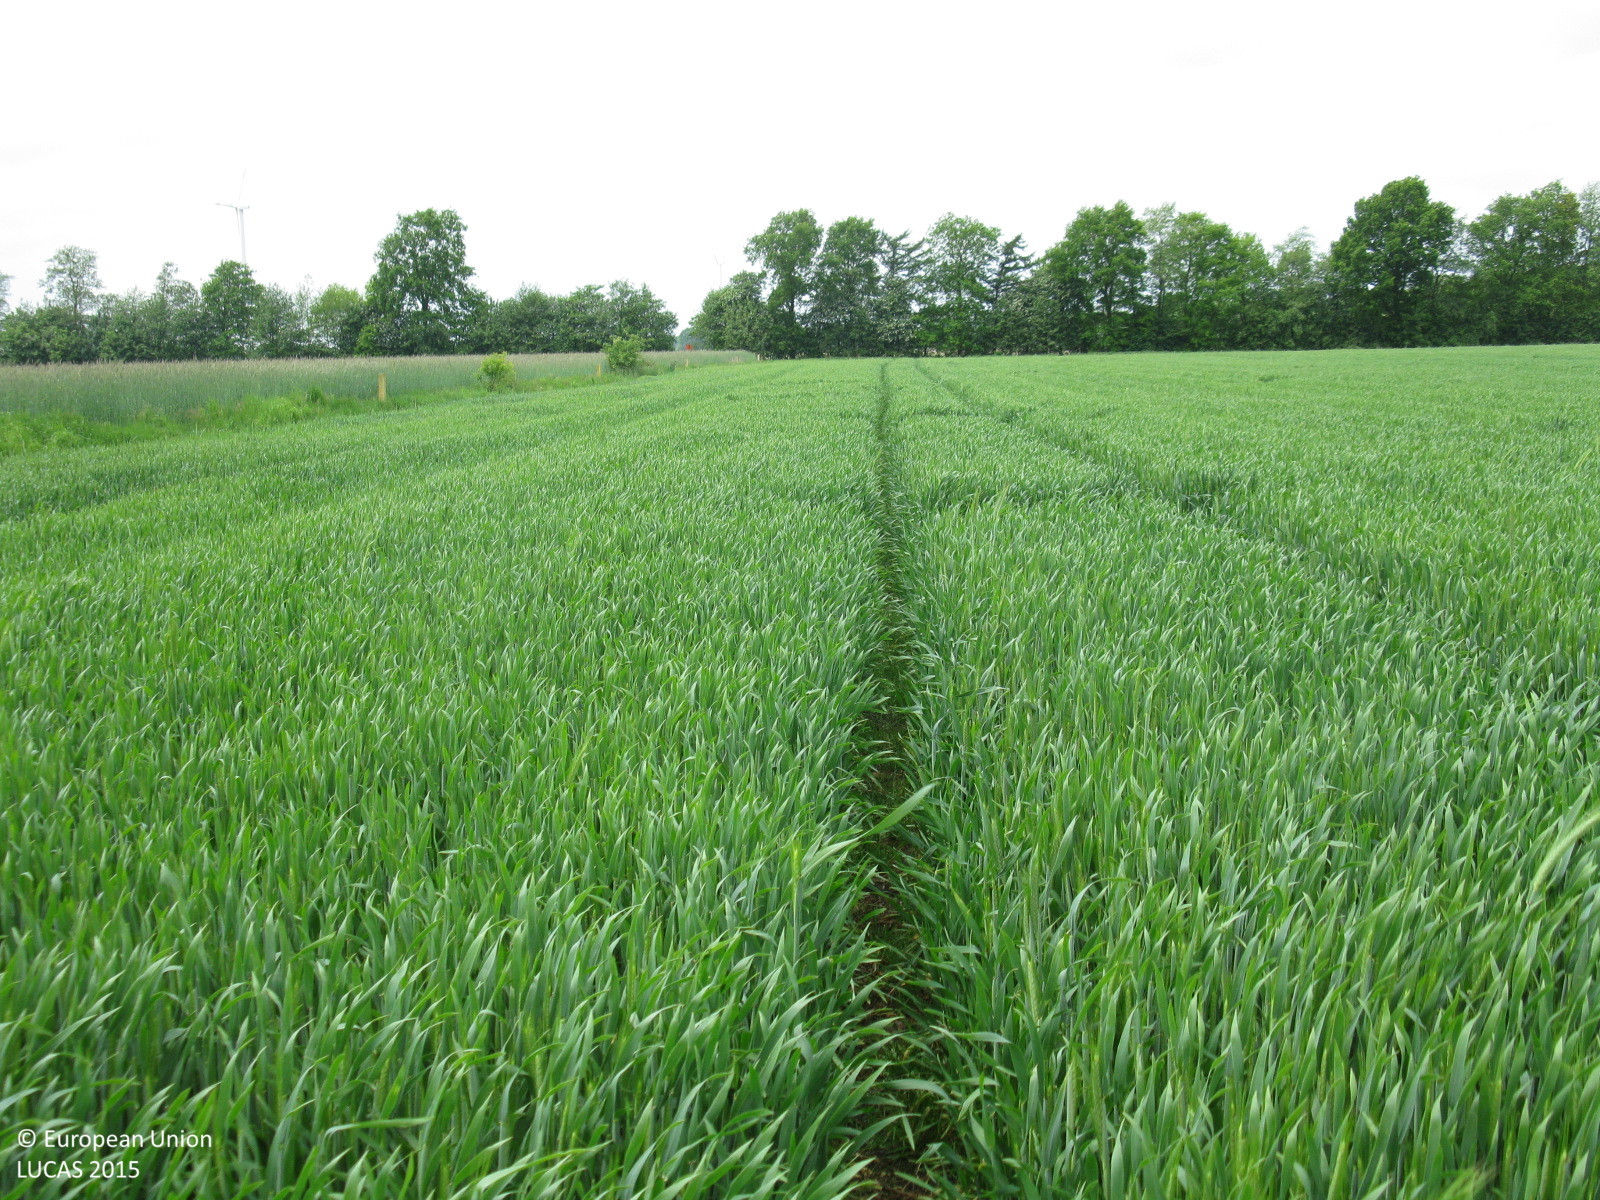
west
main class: Cropland
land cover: Triticale
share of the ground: > 75 %
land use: Agriculture (excluding fallow land and kitchen gardens)
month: May
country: DE
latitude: 52.9963
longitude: 7.3931
